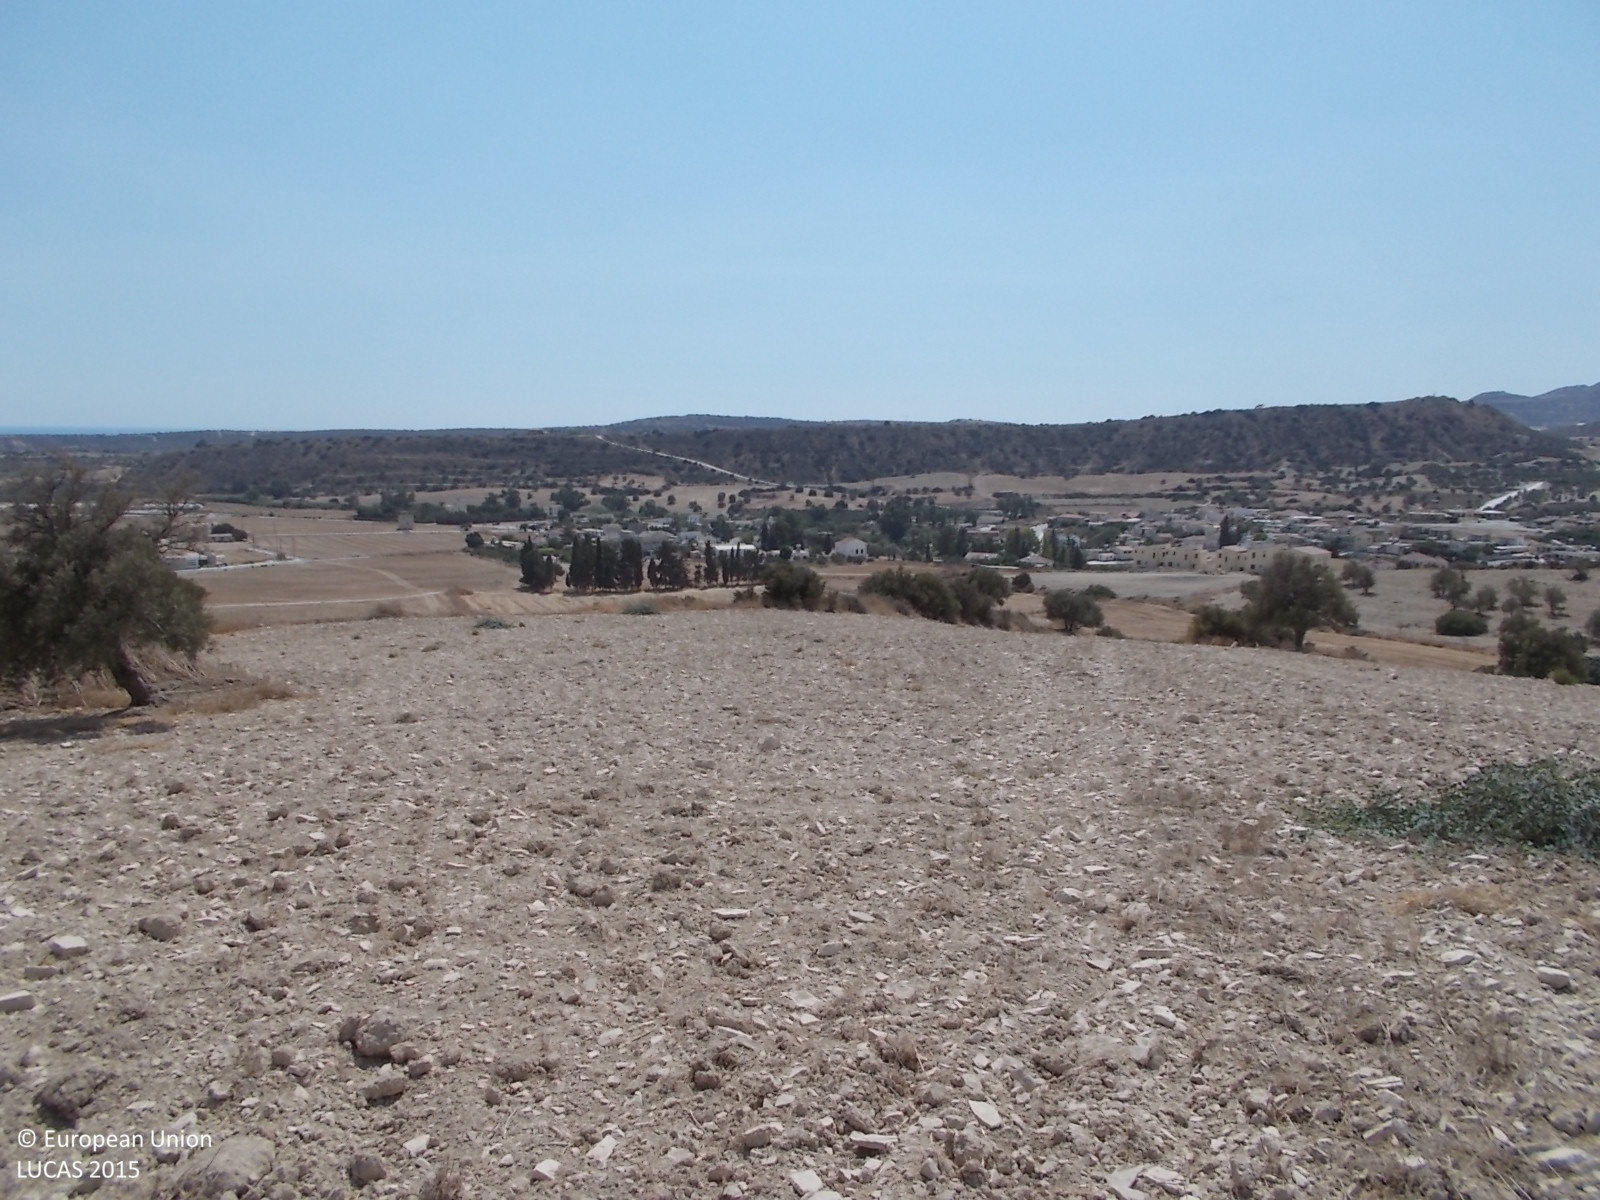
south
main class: Cropland
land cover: Olive groves
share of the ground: < 10 %
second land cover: Other bare soil
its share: > 75 %
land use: Agriculture (excluding fallow land and kitchen gardens)
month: April
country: CY
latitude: 34.8124
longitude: 33.4370
